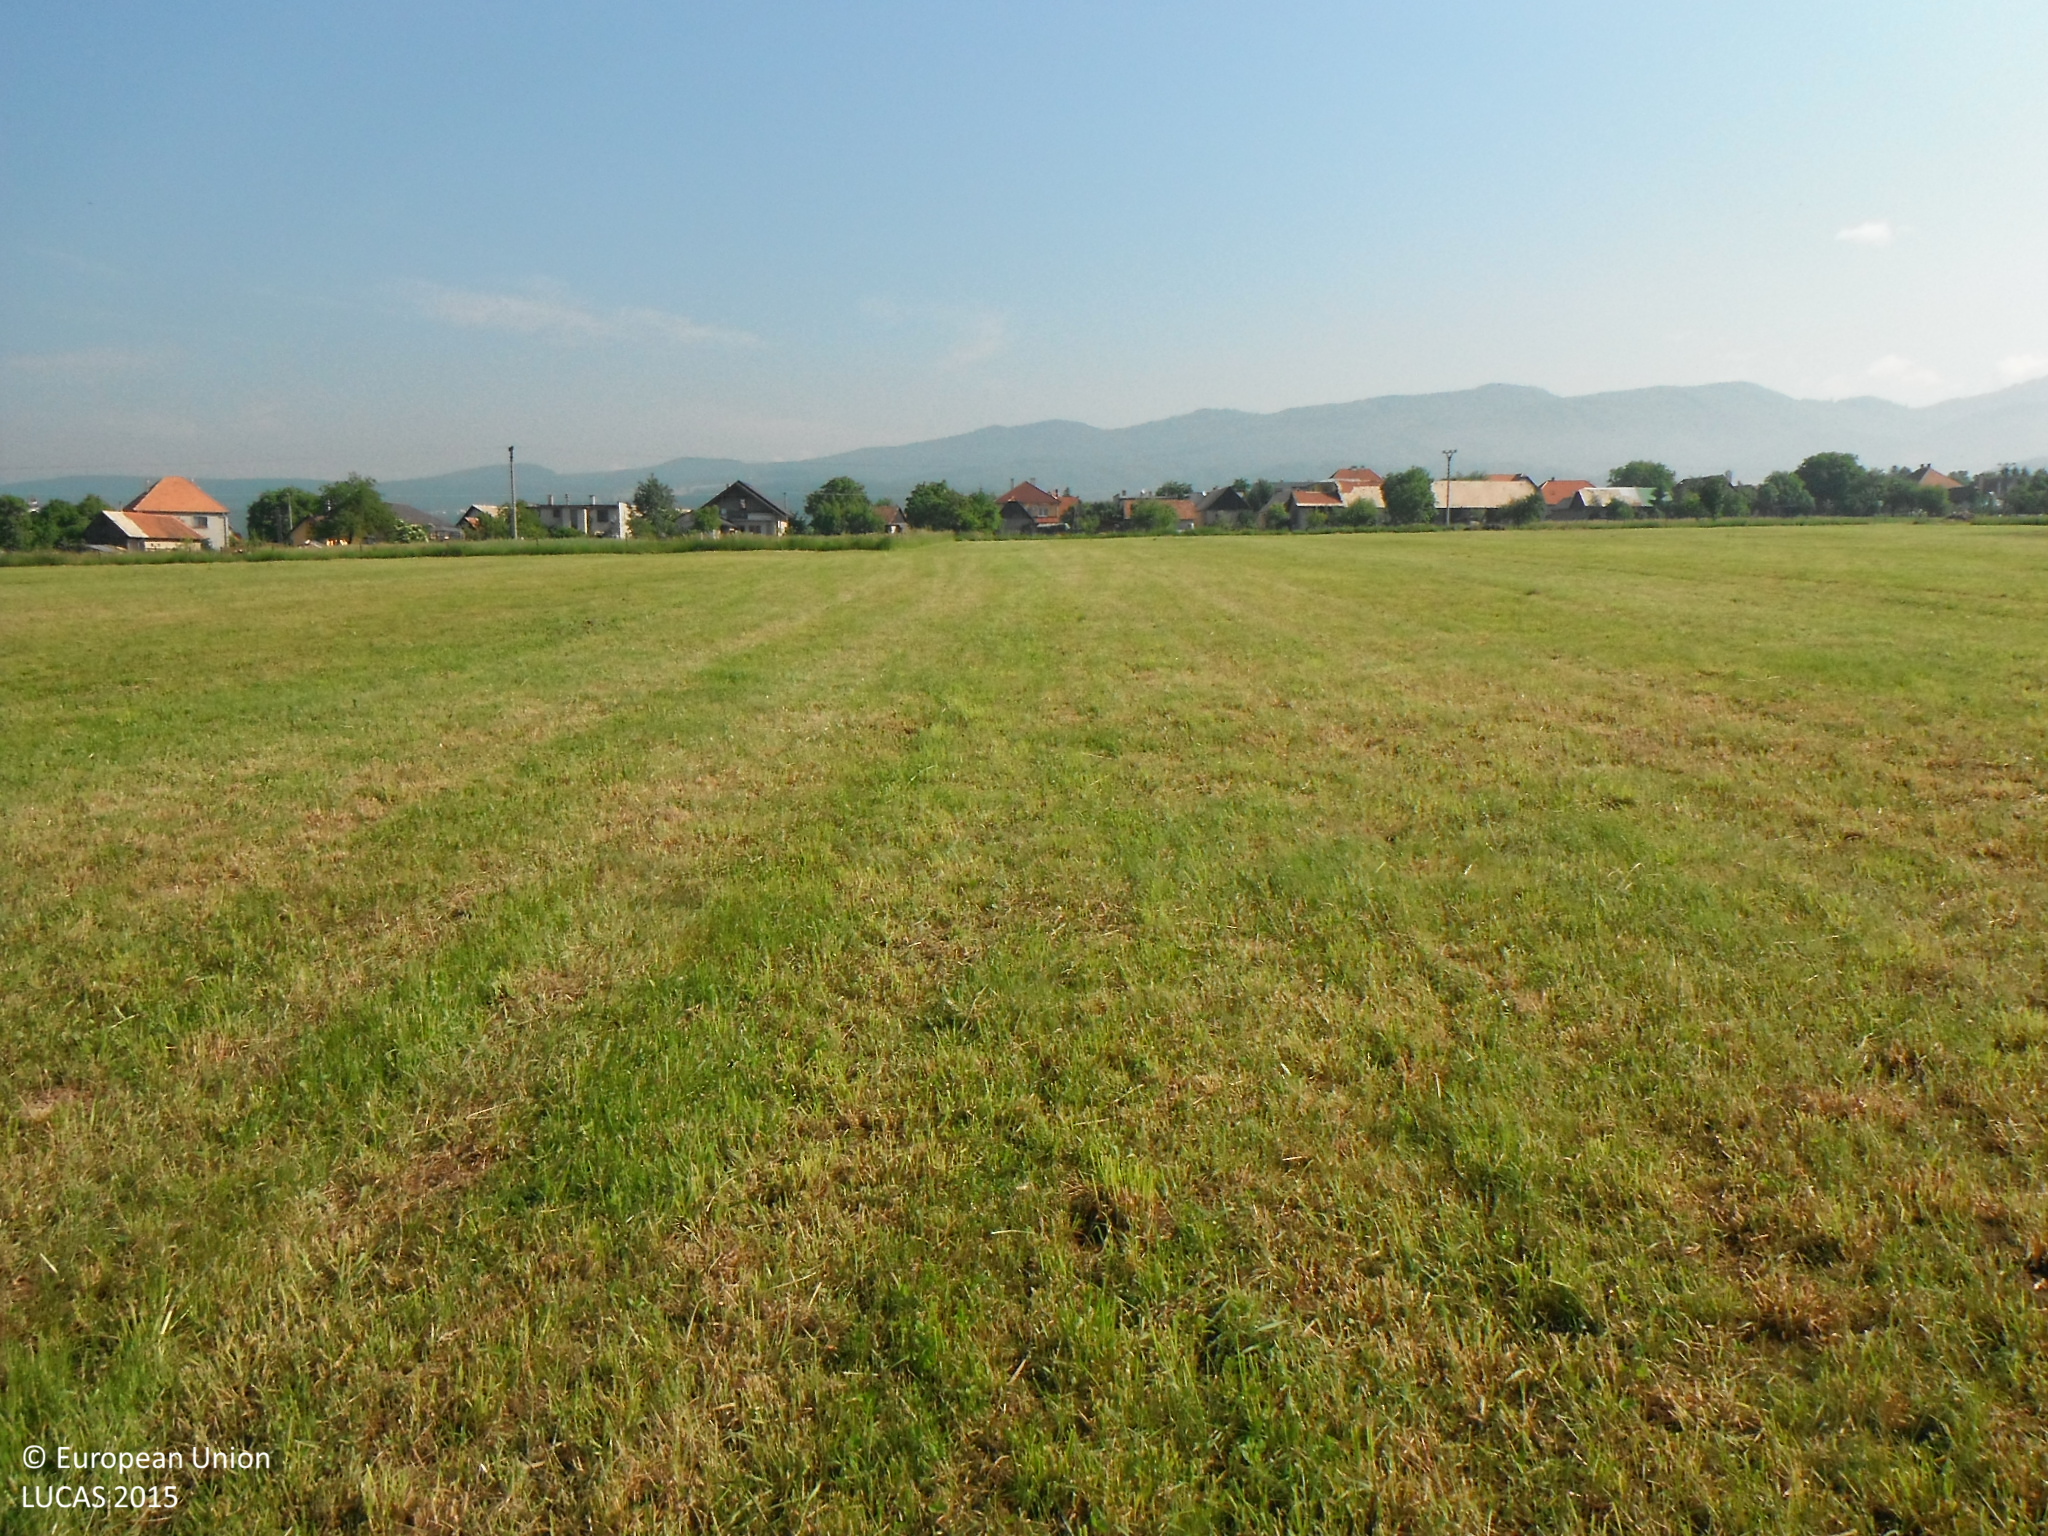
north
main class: Grassland
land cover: Grassland without tree/shrub cover
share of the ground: > 75 %
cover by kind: herbaceous plants 100 %
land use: Agriculture (excluding fallow land and kitchen gardens)
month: June
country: SK
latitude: 48.5849
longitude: 19.3642
